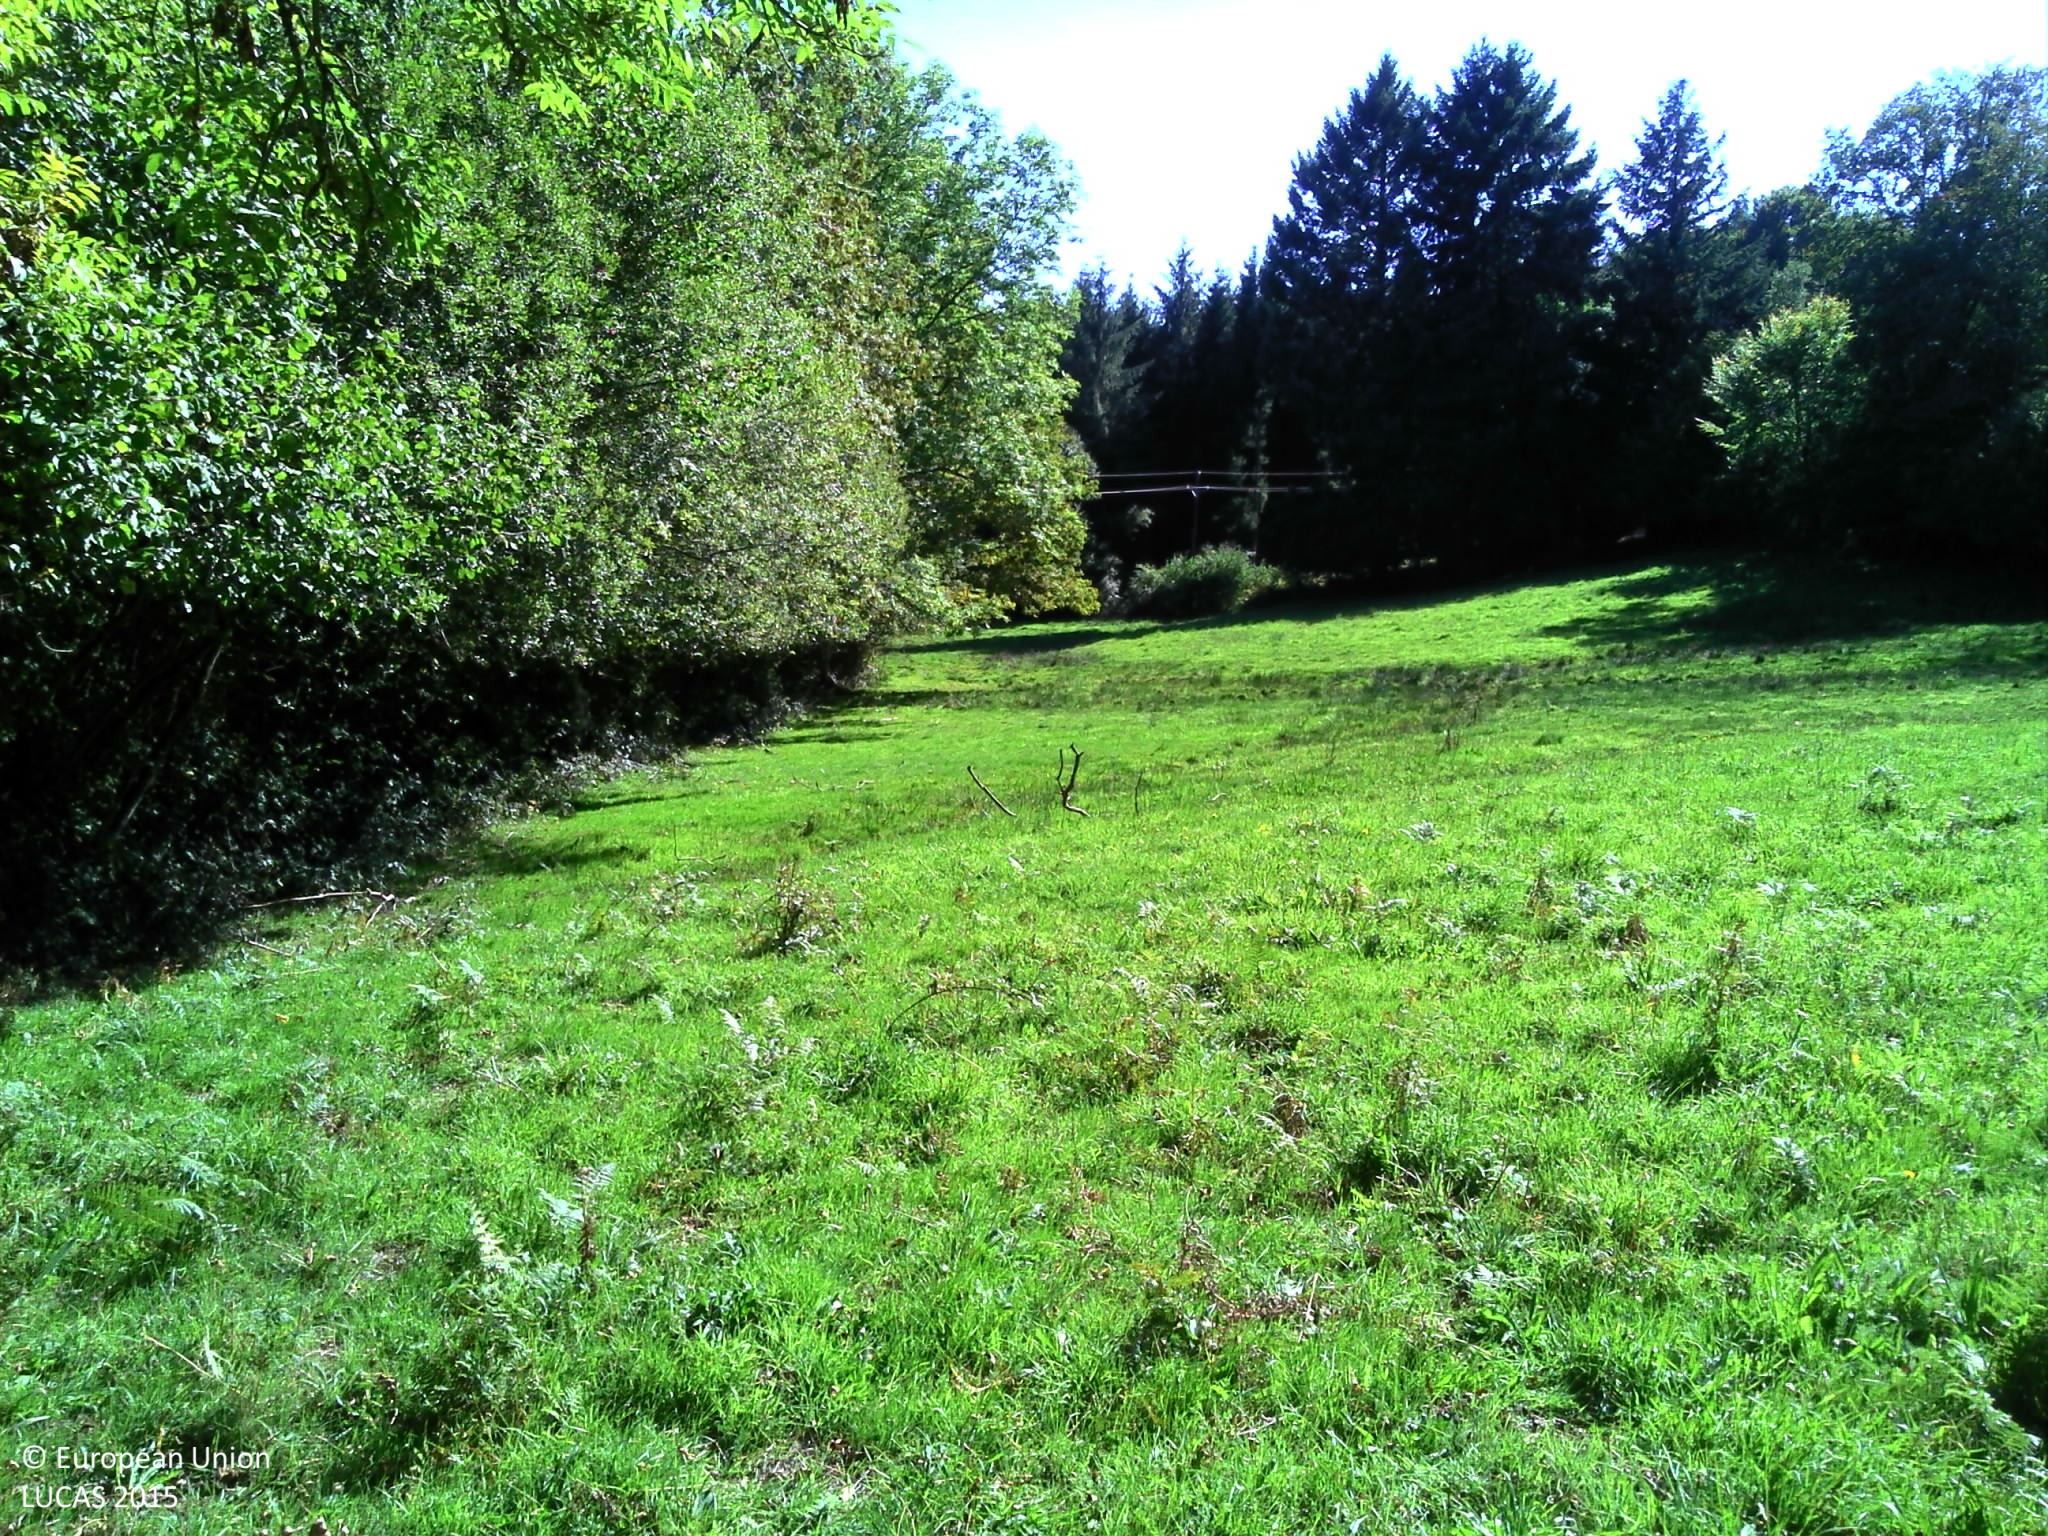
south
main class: Grassland
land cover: Grassland without tree/shrub cover
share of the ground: > 75 %
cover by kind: herbaceous plants 100 %
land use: Agriculture (excluding fallow land and kitchen gardens)
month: September
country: FR
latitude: 45.8373
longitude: 2.8015
